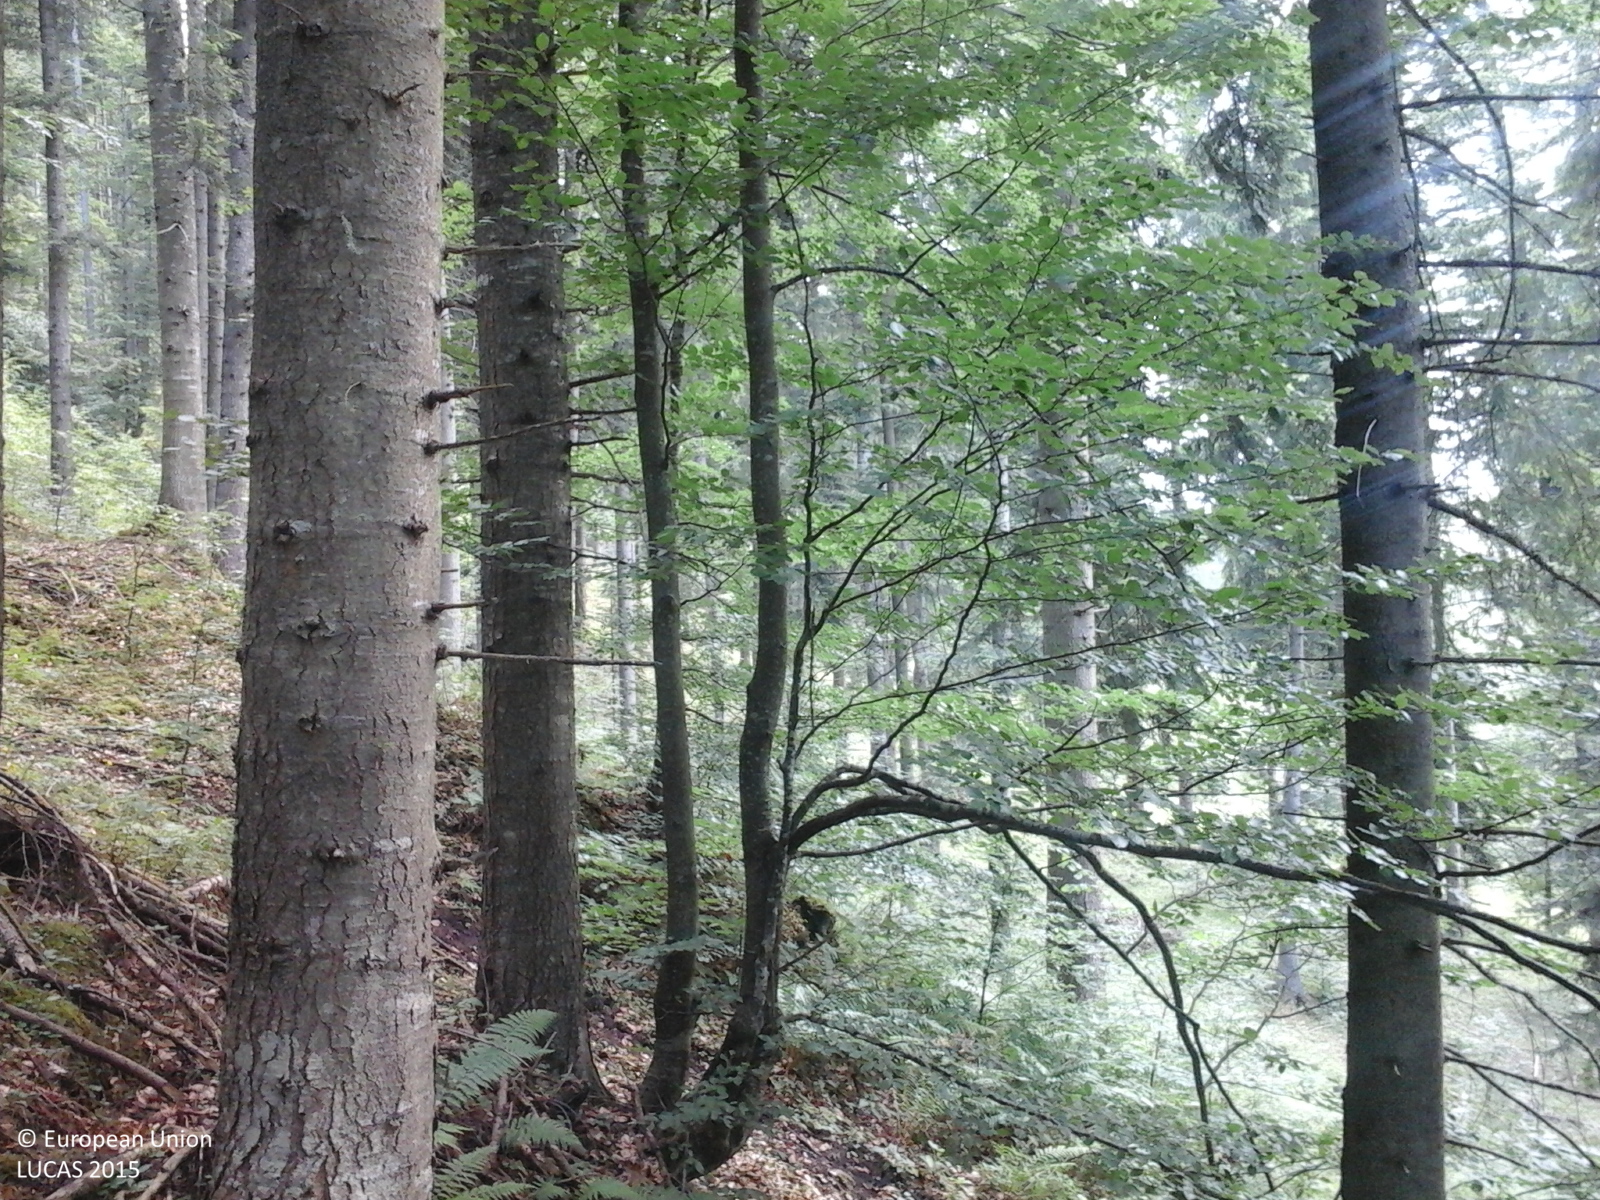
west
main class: Woodland
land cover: Other mixed woodland
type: alpine coniferous forest
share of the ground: > 75 %
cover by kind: coniferous forest trees 70 %, broadleaved forest trees 30 %
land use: Forestry
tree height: > 5 m
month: June
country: RO
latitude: 47.5742
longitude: 25.3886
